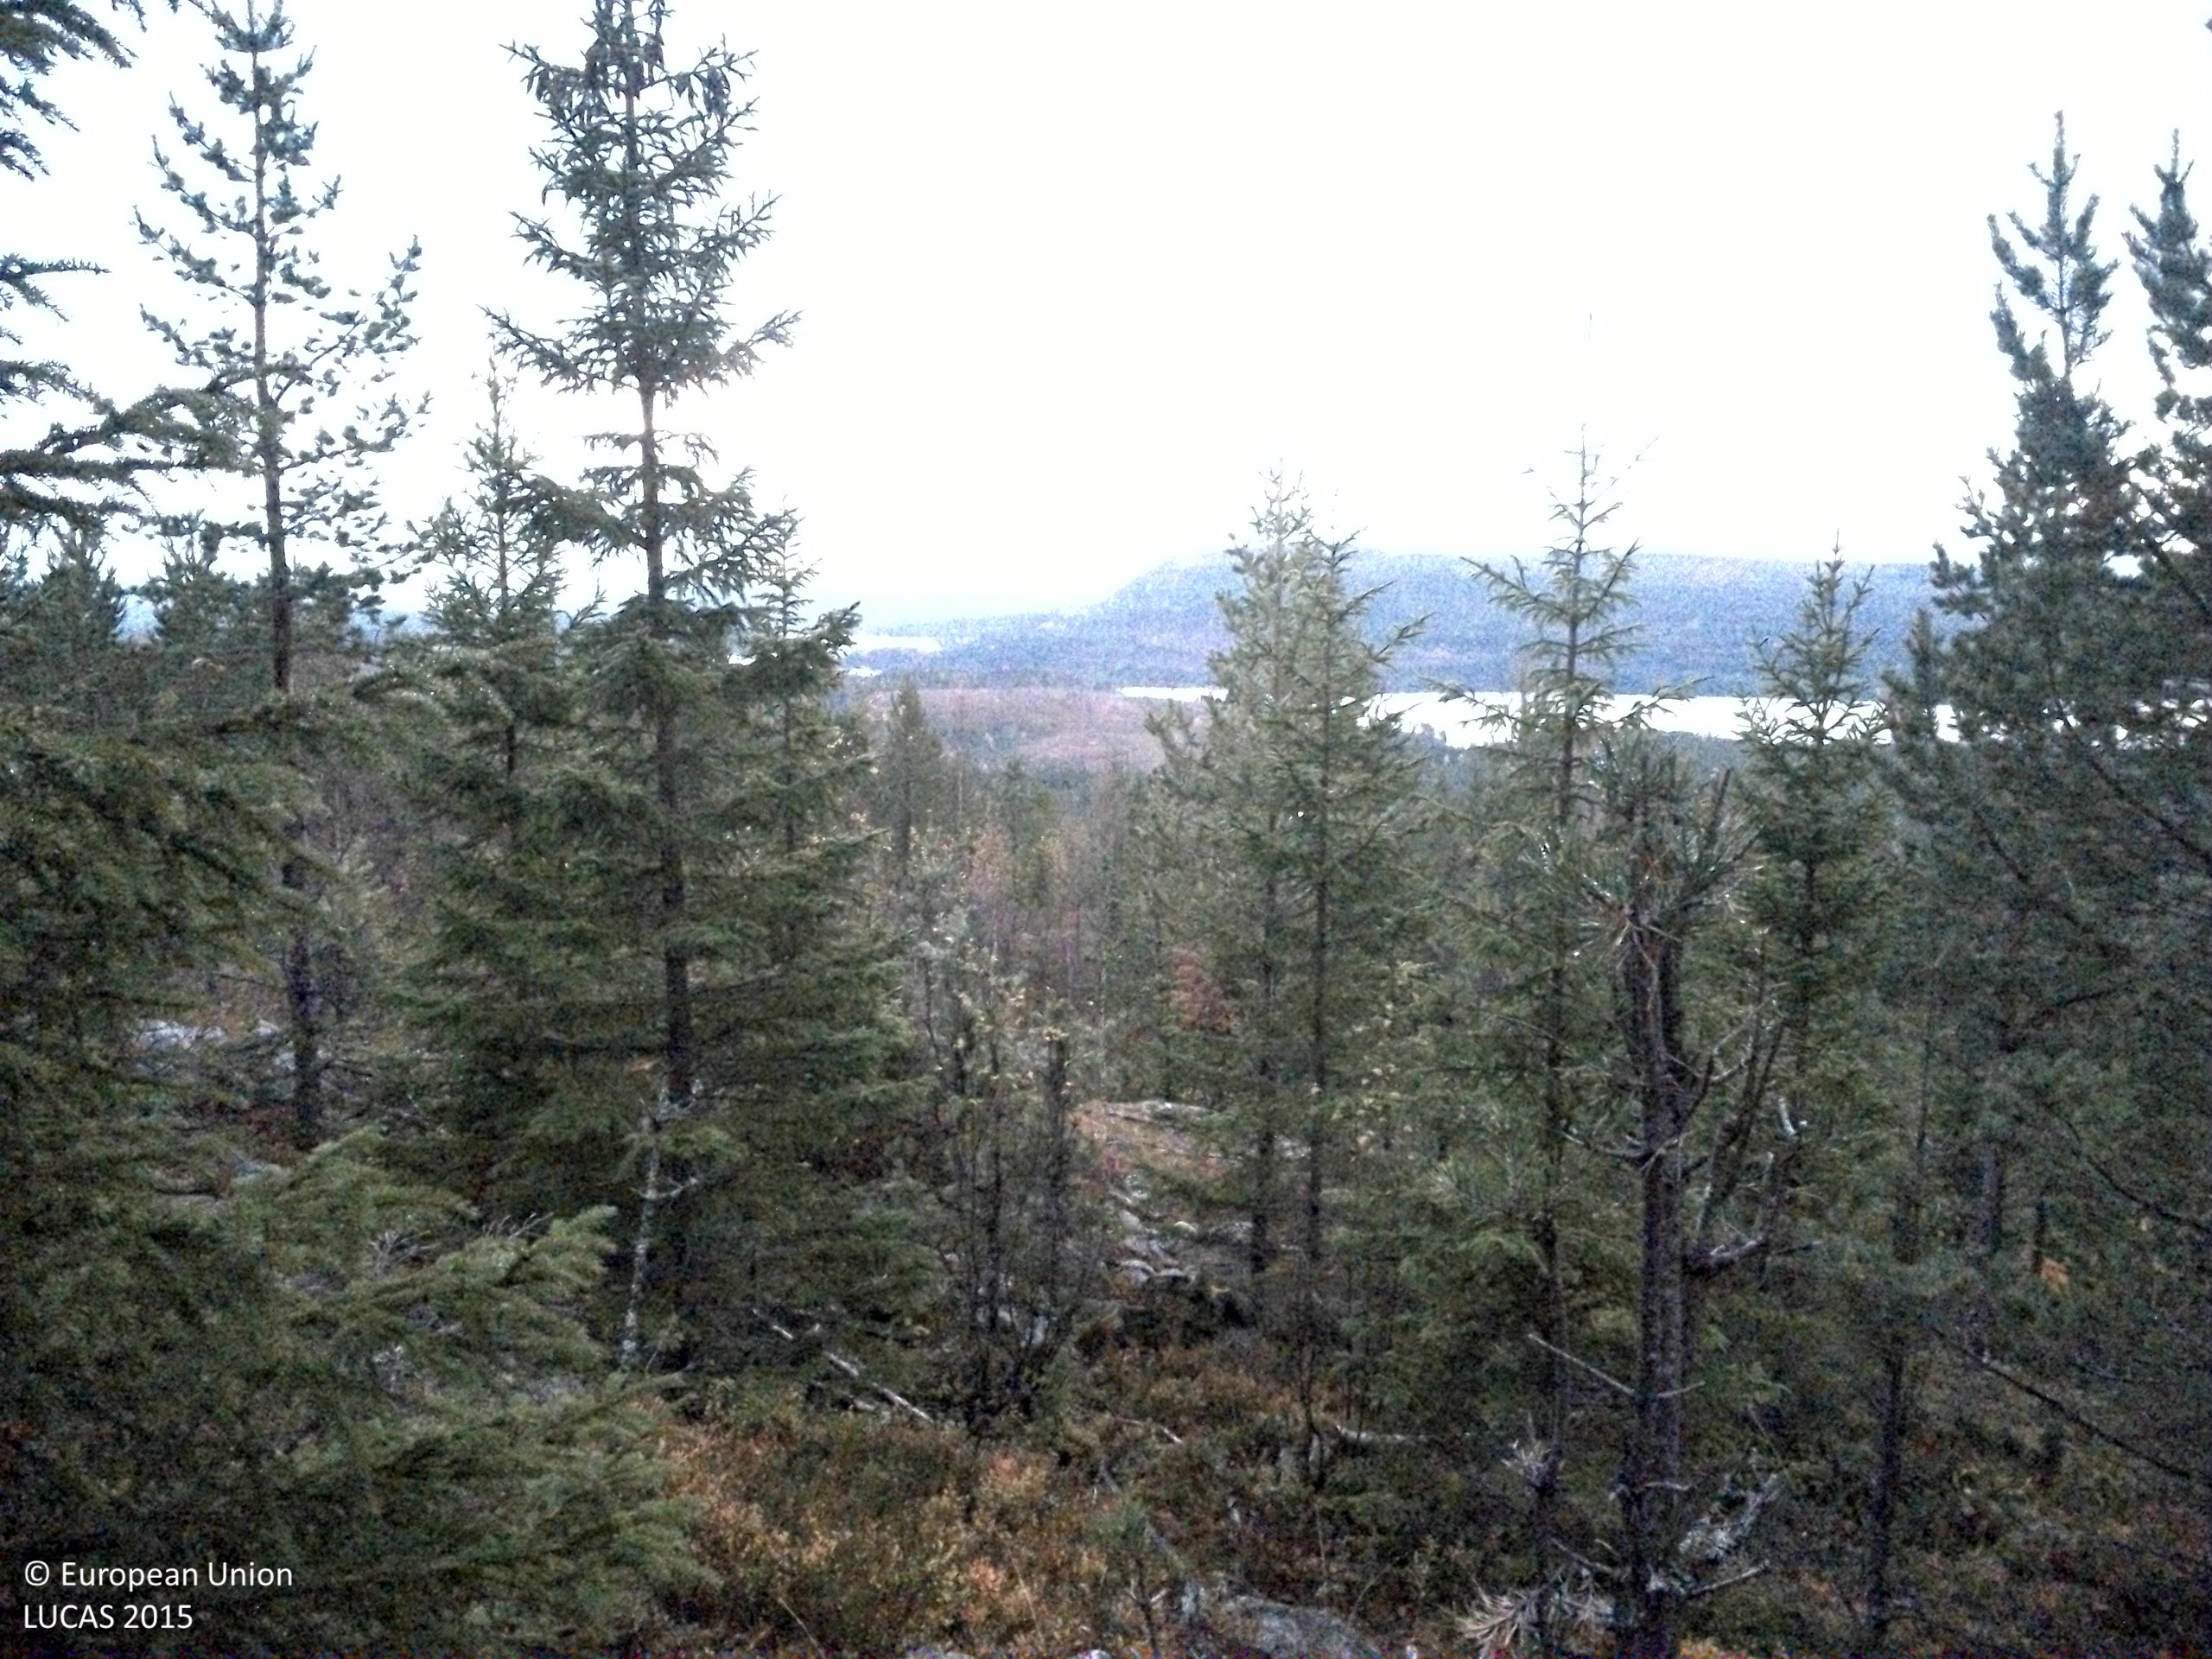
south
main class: Woodland
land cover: Pine dominated coniferous woodland
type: boreal forest
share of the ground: 25 - 50 %
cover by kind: coniferous forest trees 35 %, shrubs 25 %, consolidated bare surface 20 %, lichens and mosses 15 %, broadleaved forest trees 5 %
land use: Forestry
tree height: > 5 m
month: October
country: SE
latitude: 64.3308
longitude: 15.2066
